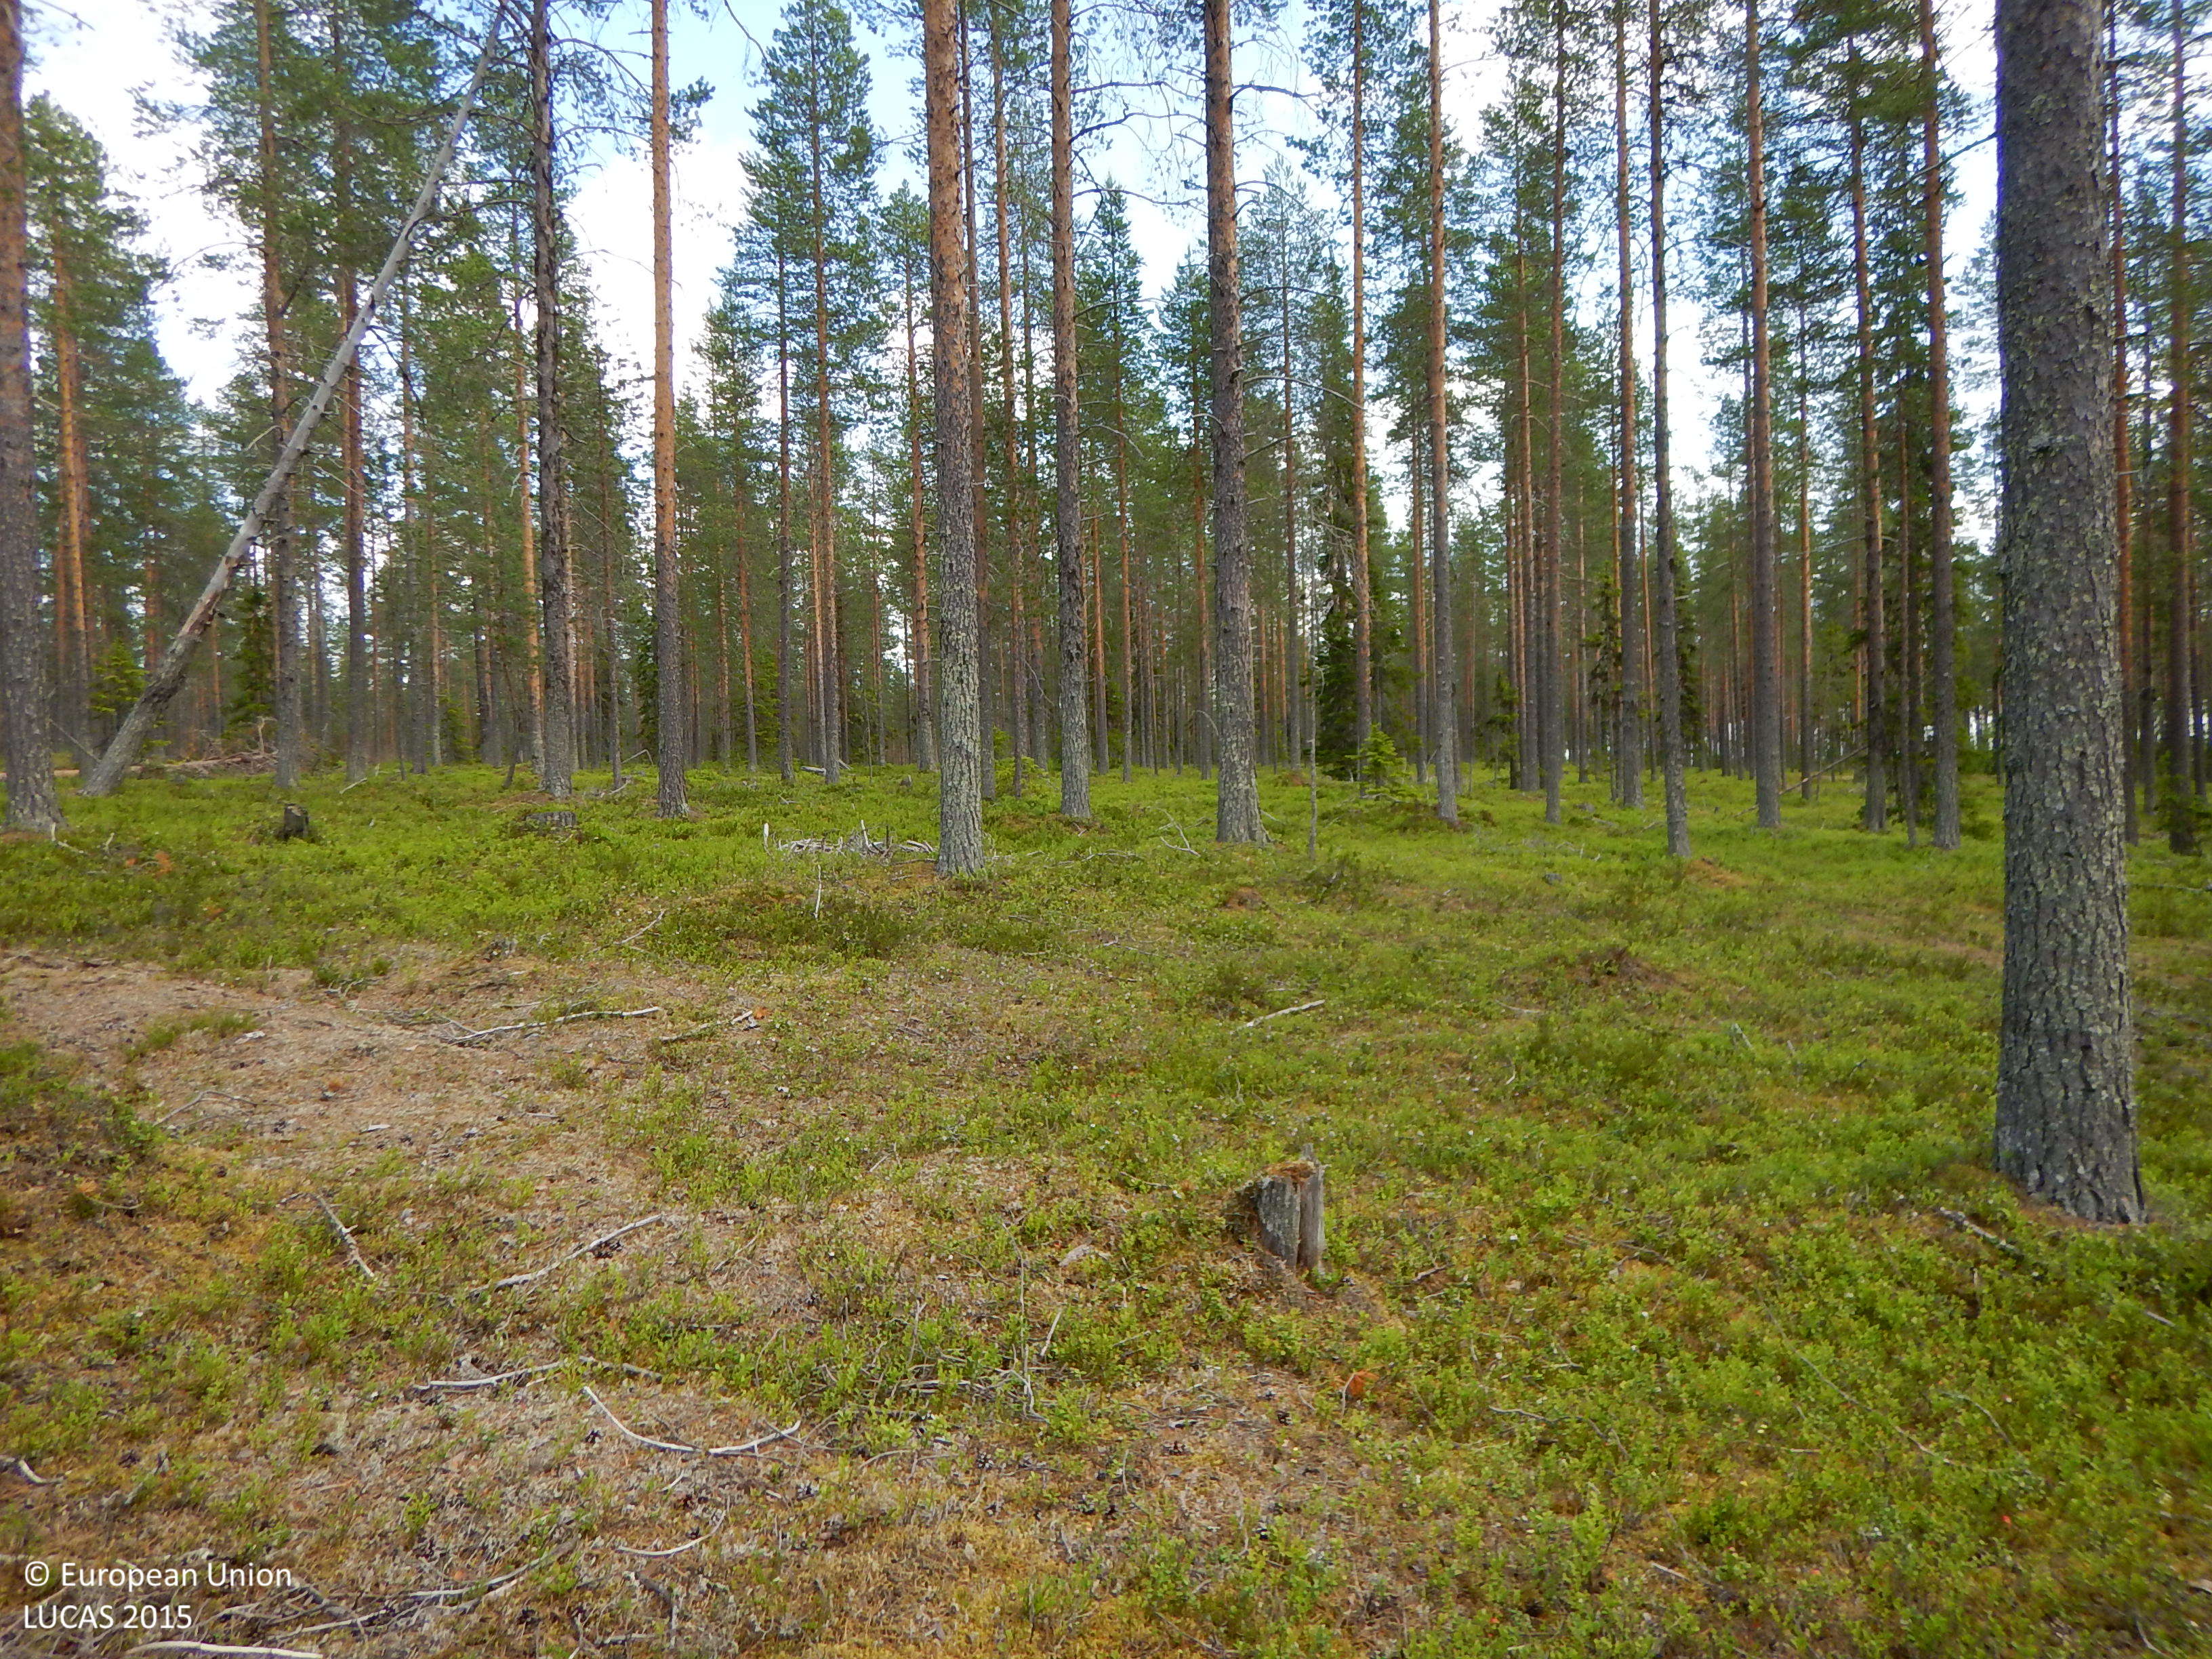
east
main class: Woodland
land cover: Pine dominated coniferous woodland
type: boreal forest
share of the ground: 50 - 75 %
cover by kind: coniferous forest trees 50 %, lichens and mosses 20 %, shrubs 15 %, herbaceous plants 15 %
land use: Forestry
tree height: > 5 m
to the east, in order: Pine dominated coniferous woodland
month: July
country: SE
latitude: 65.0346
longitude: 19.9275
